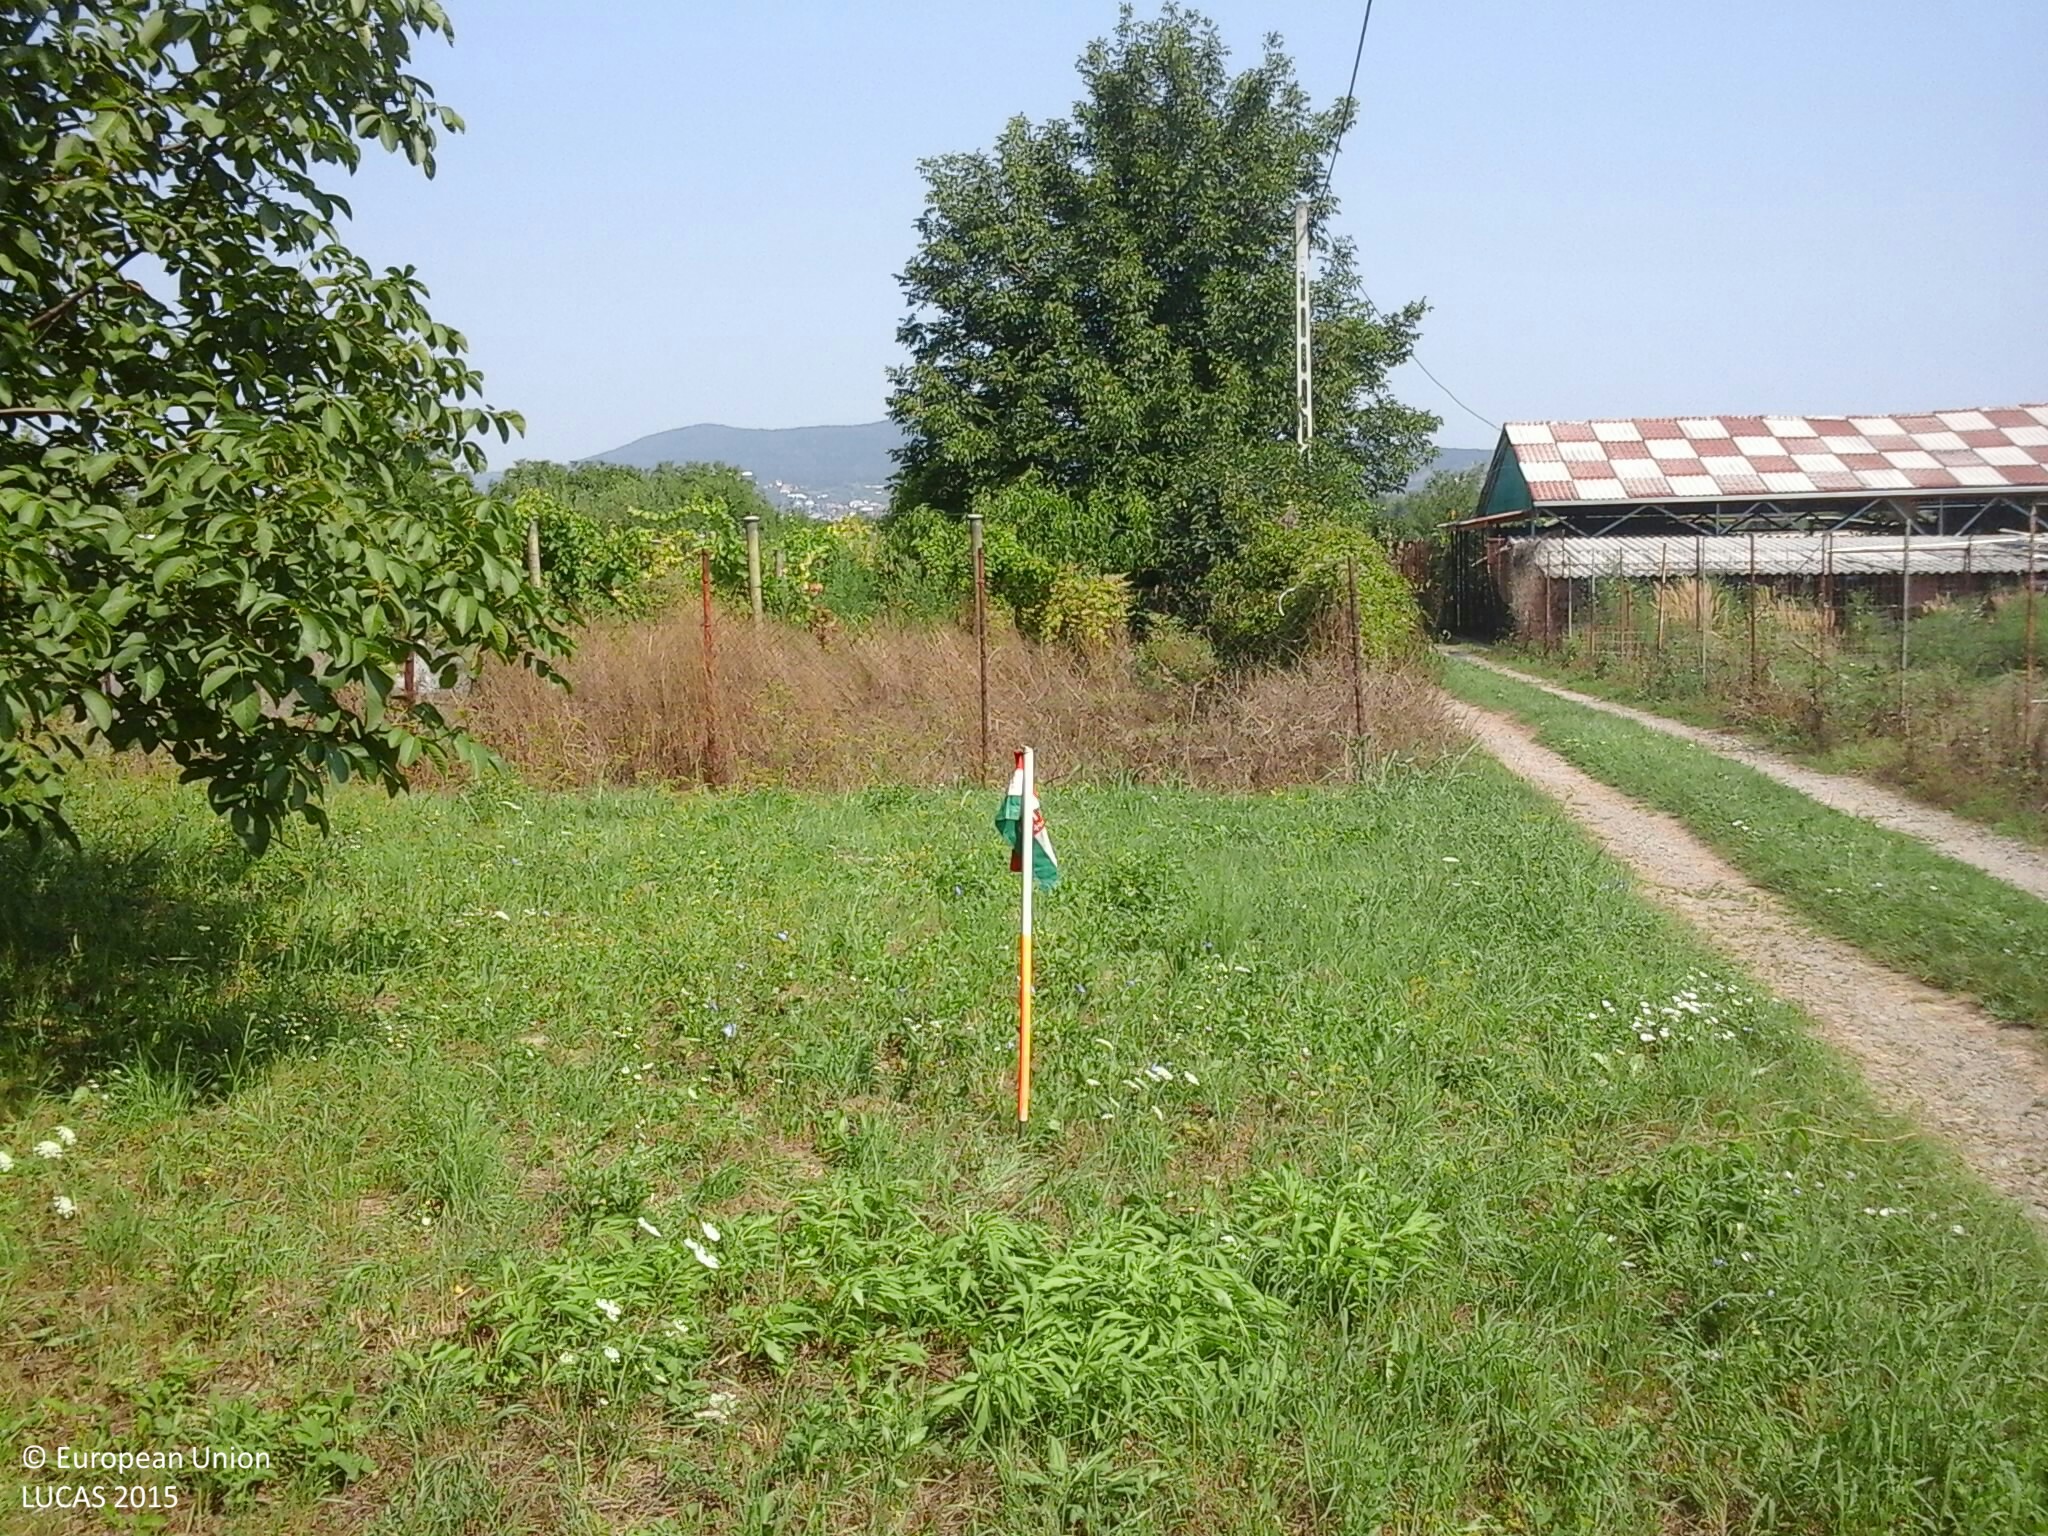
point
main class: Grassland
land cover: Grassland with sparse tree/shrub cover
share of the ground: > 75 %
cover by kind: herbaceous plants 95 %, broadleaved forest trees 5 %
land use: Abandoned areas
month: August
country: HU
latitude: 46.0510
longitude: 18.2399
